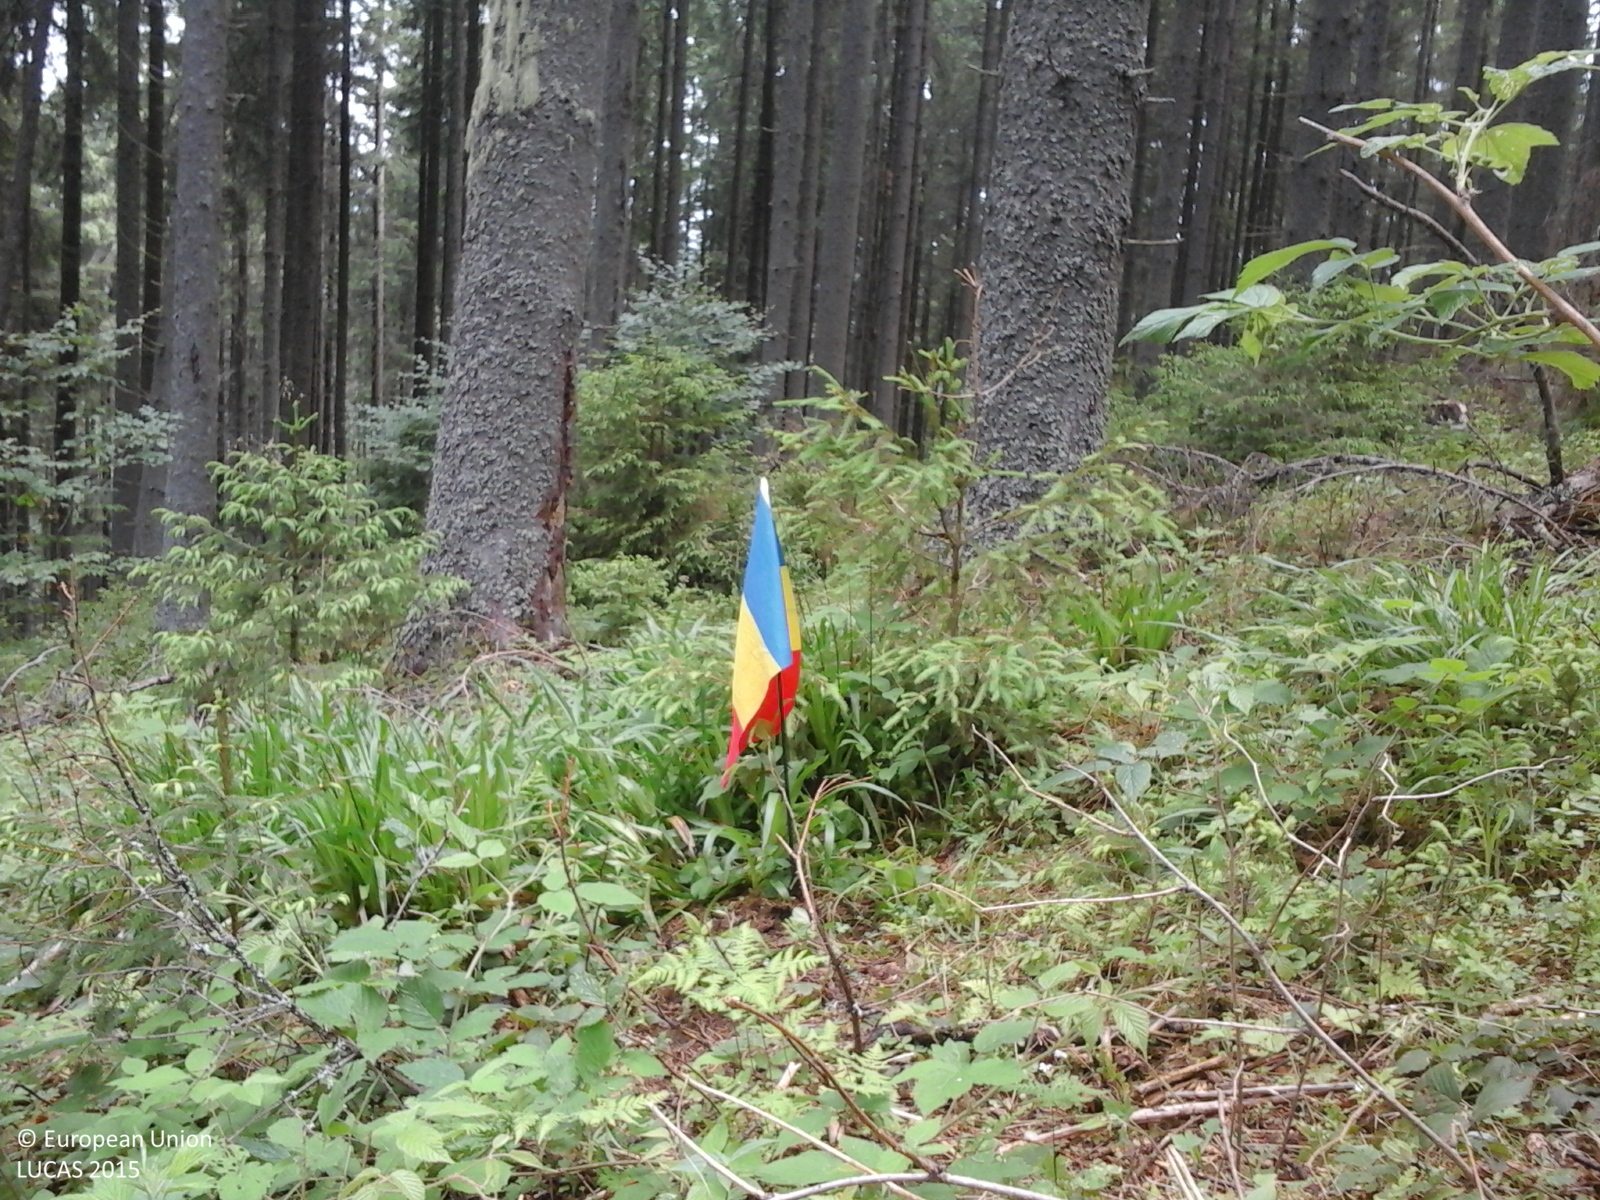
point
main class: Woodland
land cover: Spruce dominated coniferous woodland
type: alpine coniferous forest
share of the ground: > 75 %
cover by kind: coniferous forest trees 100 %
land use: Forestry
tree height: > 5 m
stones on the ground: < 10 %
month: June
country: RO
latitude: 47.4069
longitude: 25.1480
